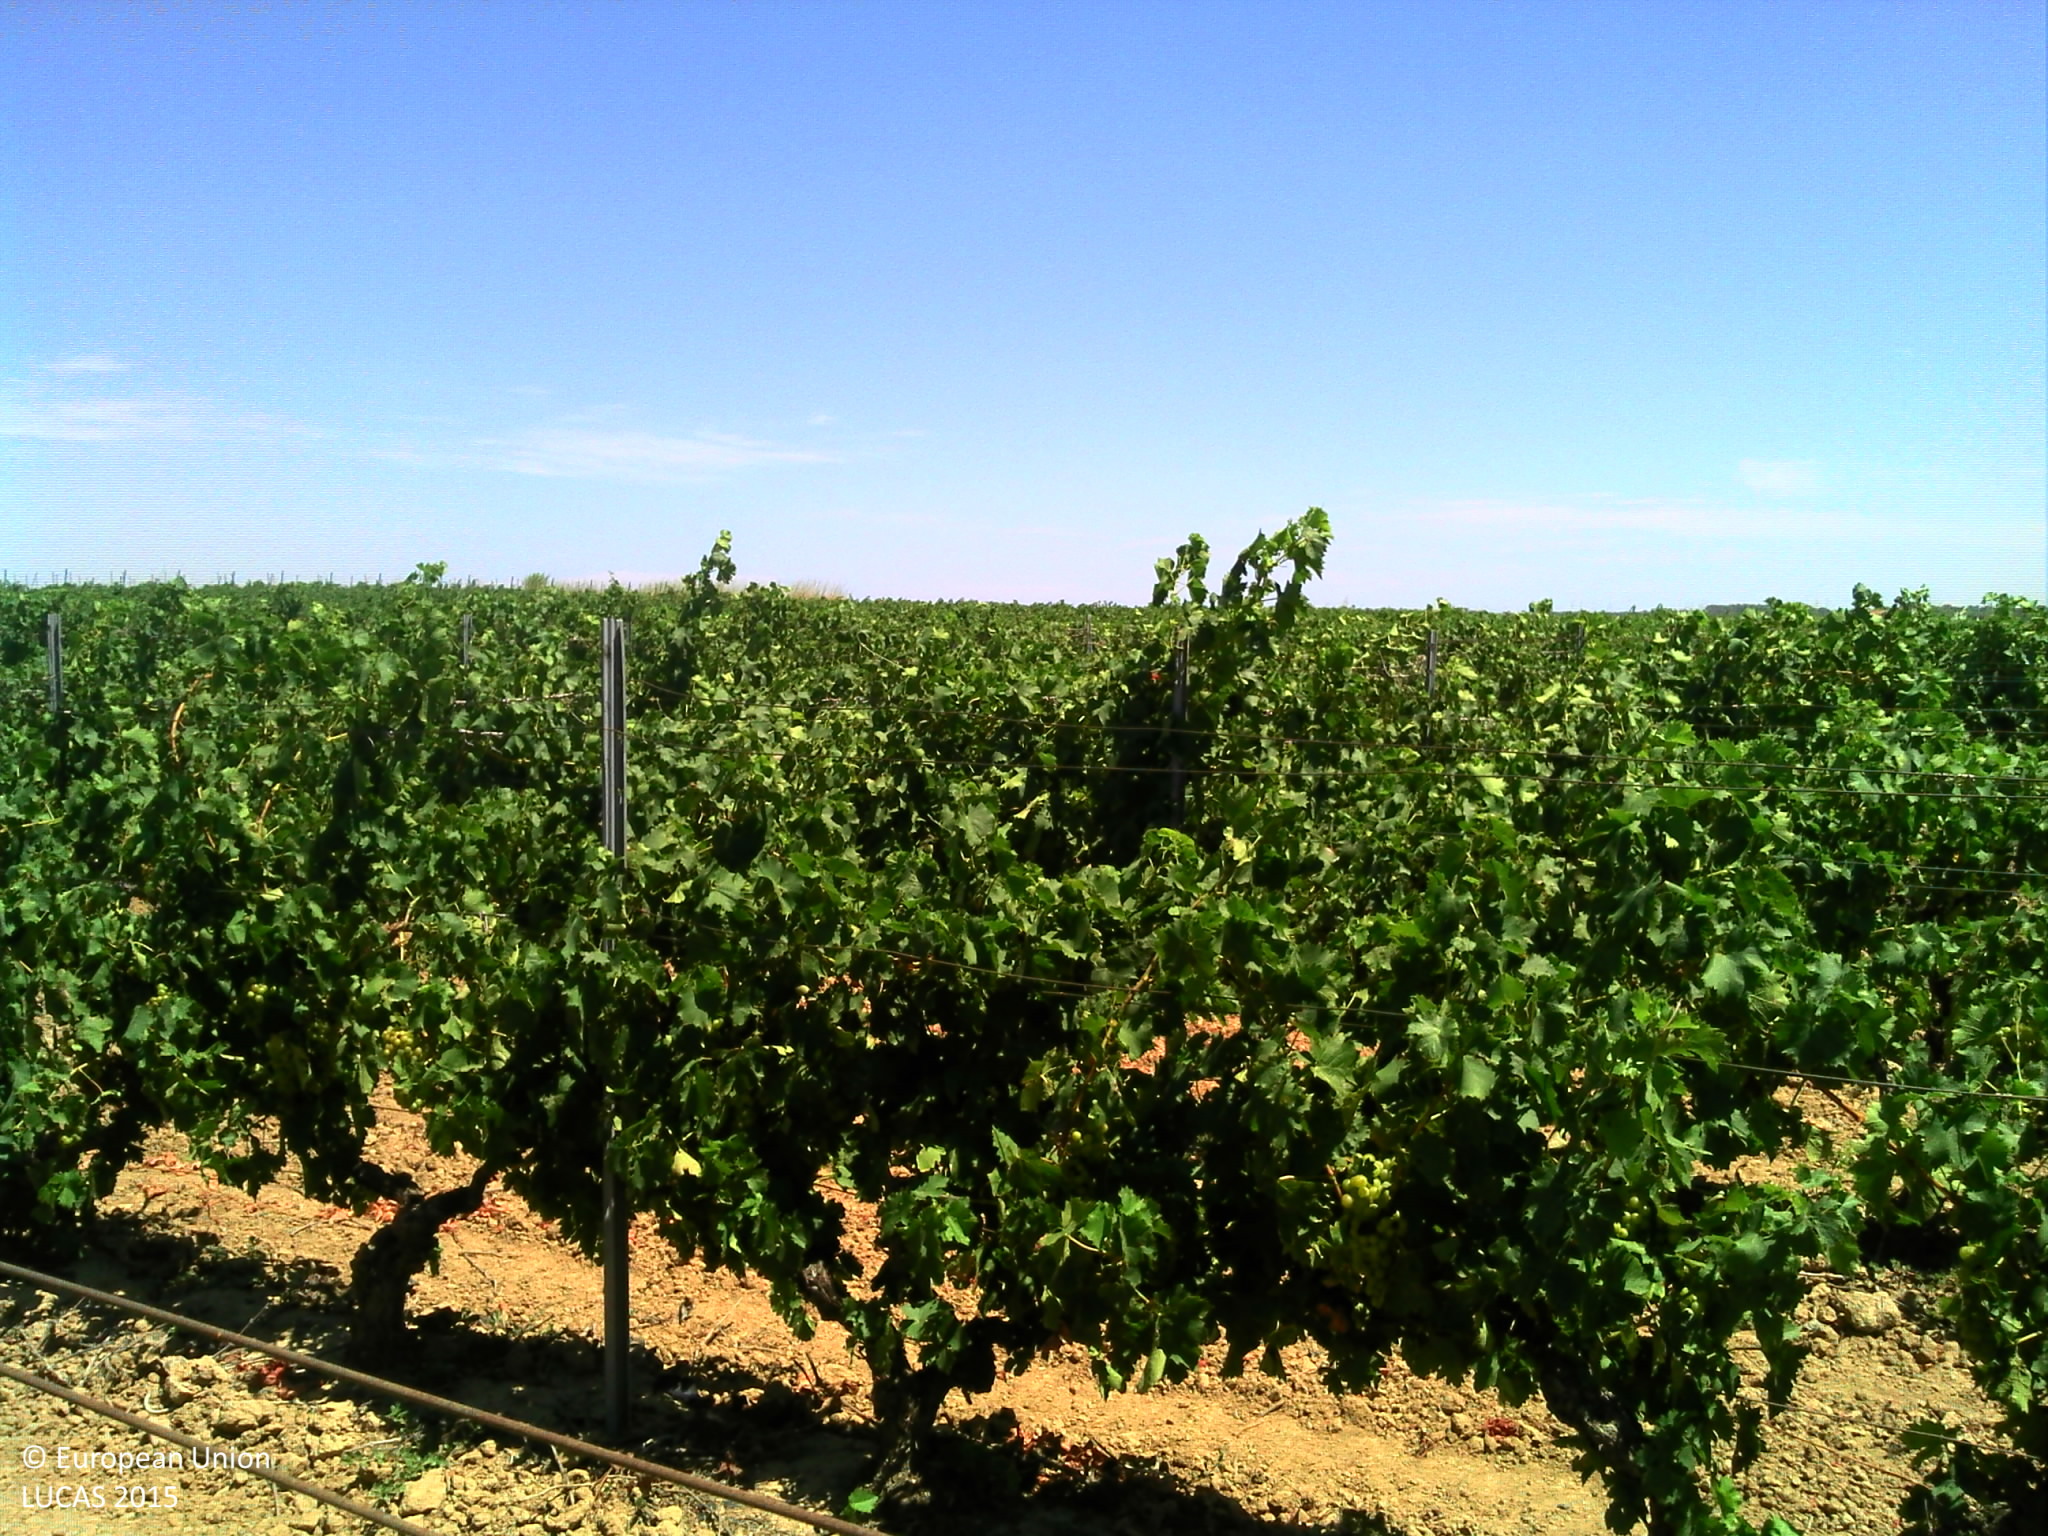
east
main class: Cropland
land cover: Vineyards
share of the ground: 50 - 75 %
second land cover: Other bare soil
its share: > 75 %
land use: Agriculture (excluding fallow land and kitchen gardens)
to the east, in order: Vineyards; Other bare soil; Spontaneously vegetated surfaces; Paved roads, cycling and walking lanes; Spontaneously vegetated surfaces; Tracks; Grass margins; Durum wheat
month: July
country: FR
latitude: 42.6224
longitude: 2.9042
